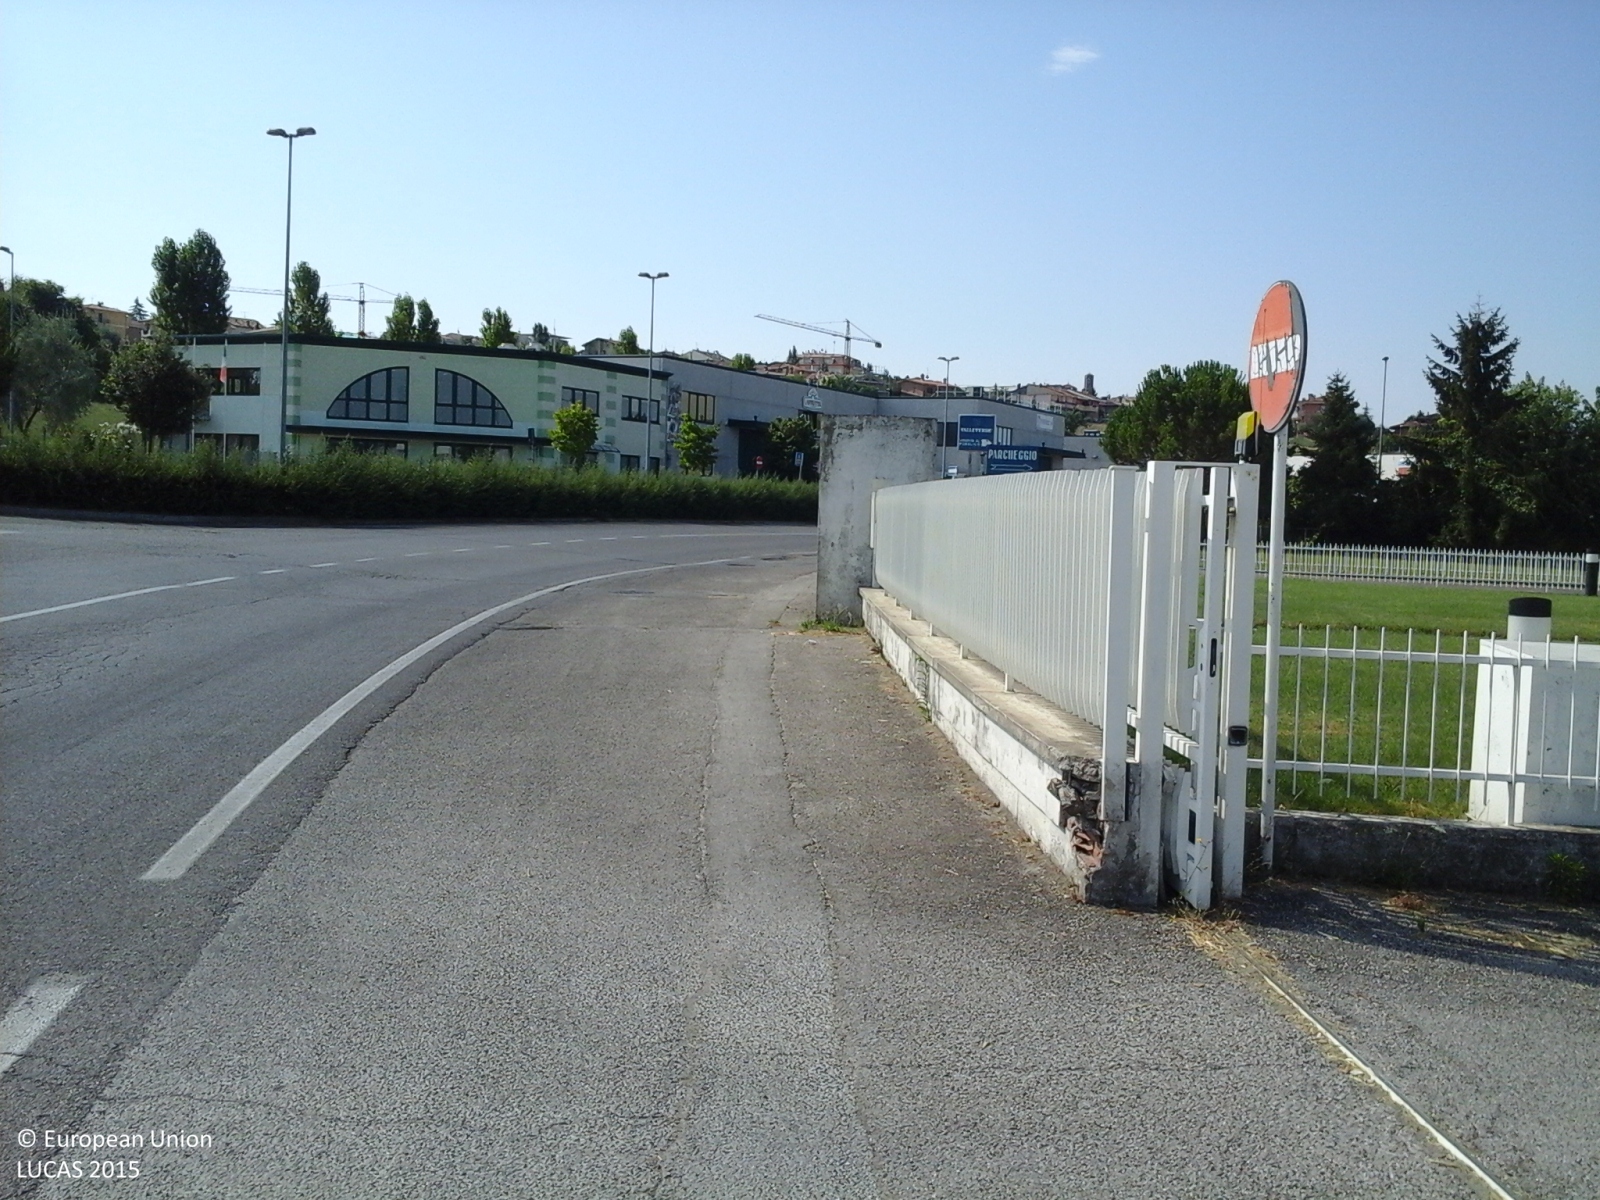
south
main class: Grassland
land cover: Grassland without tree/shrub cover
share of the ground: > 75 %
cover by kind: herbaceous plants 100 %
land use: Manufacturing of textile products
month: July
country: IT
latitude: 43.9751
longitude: 12.5993
